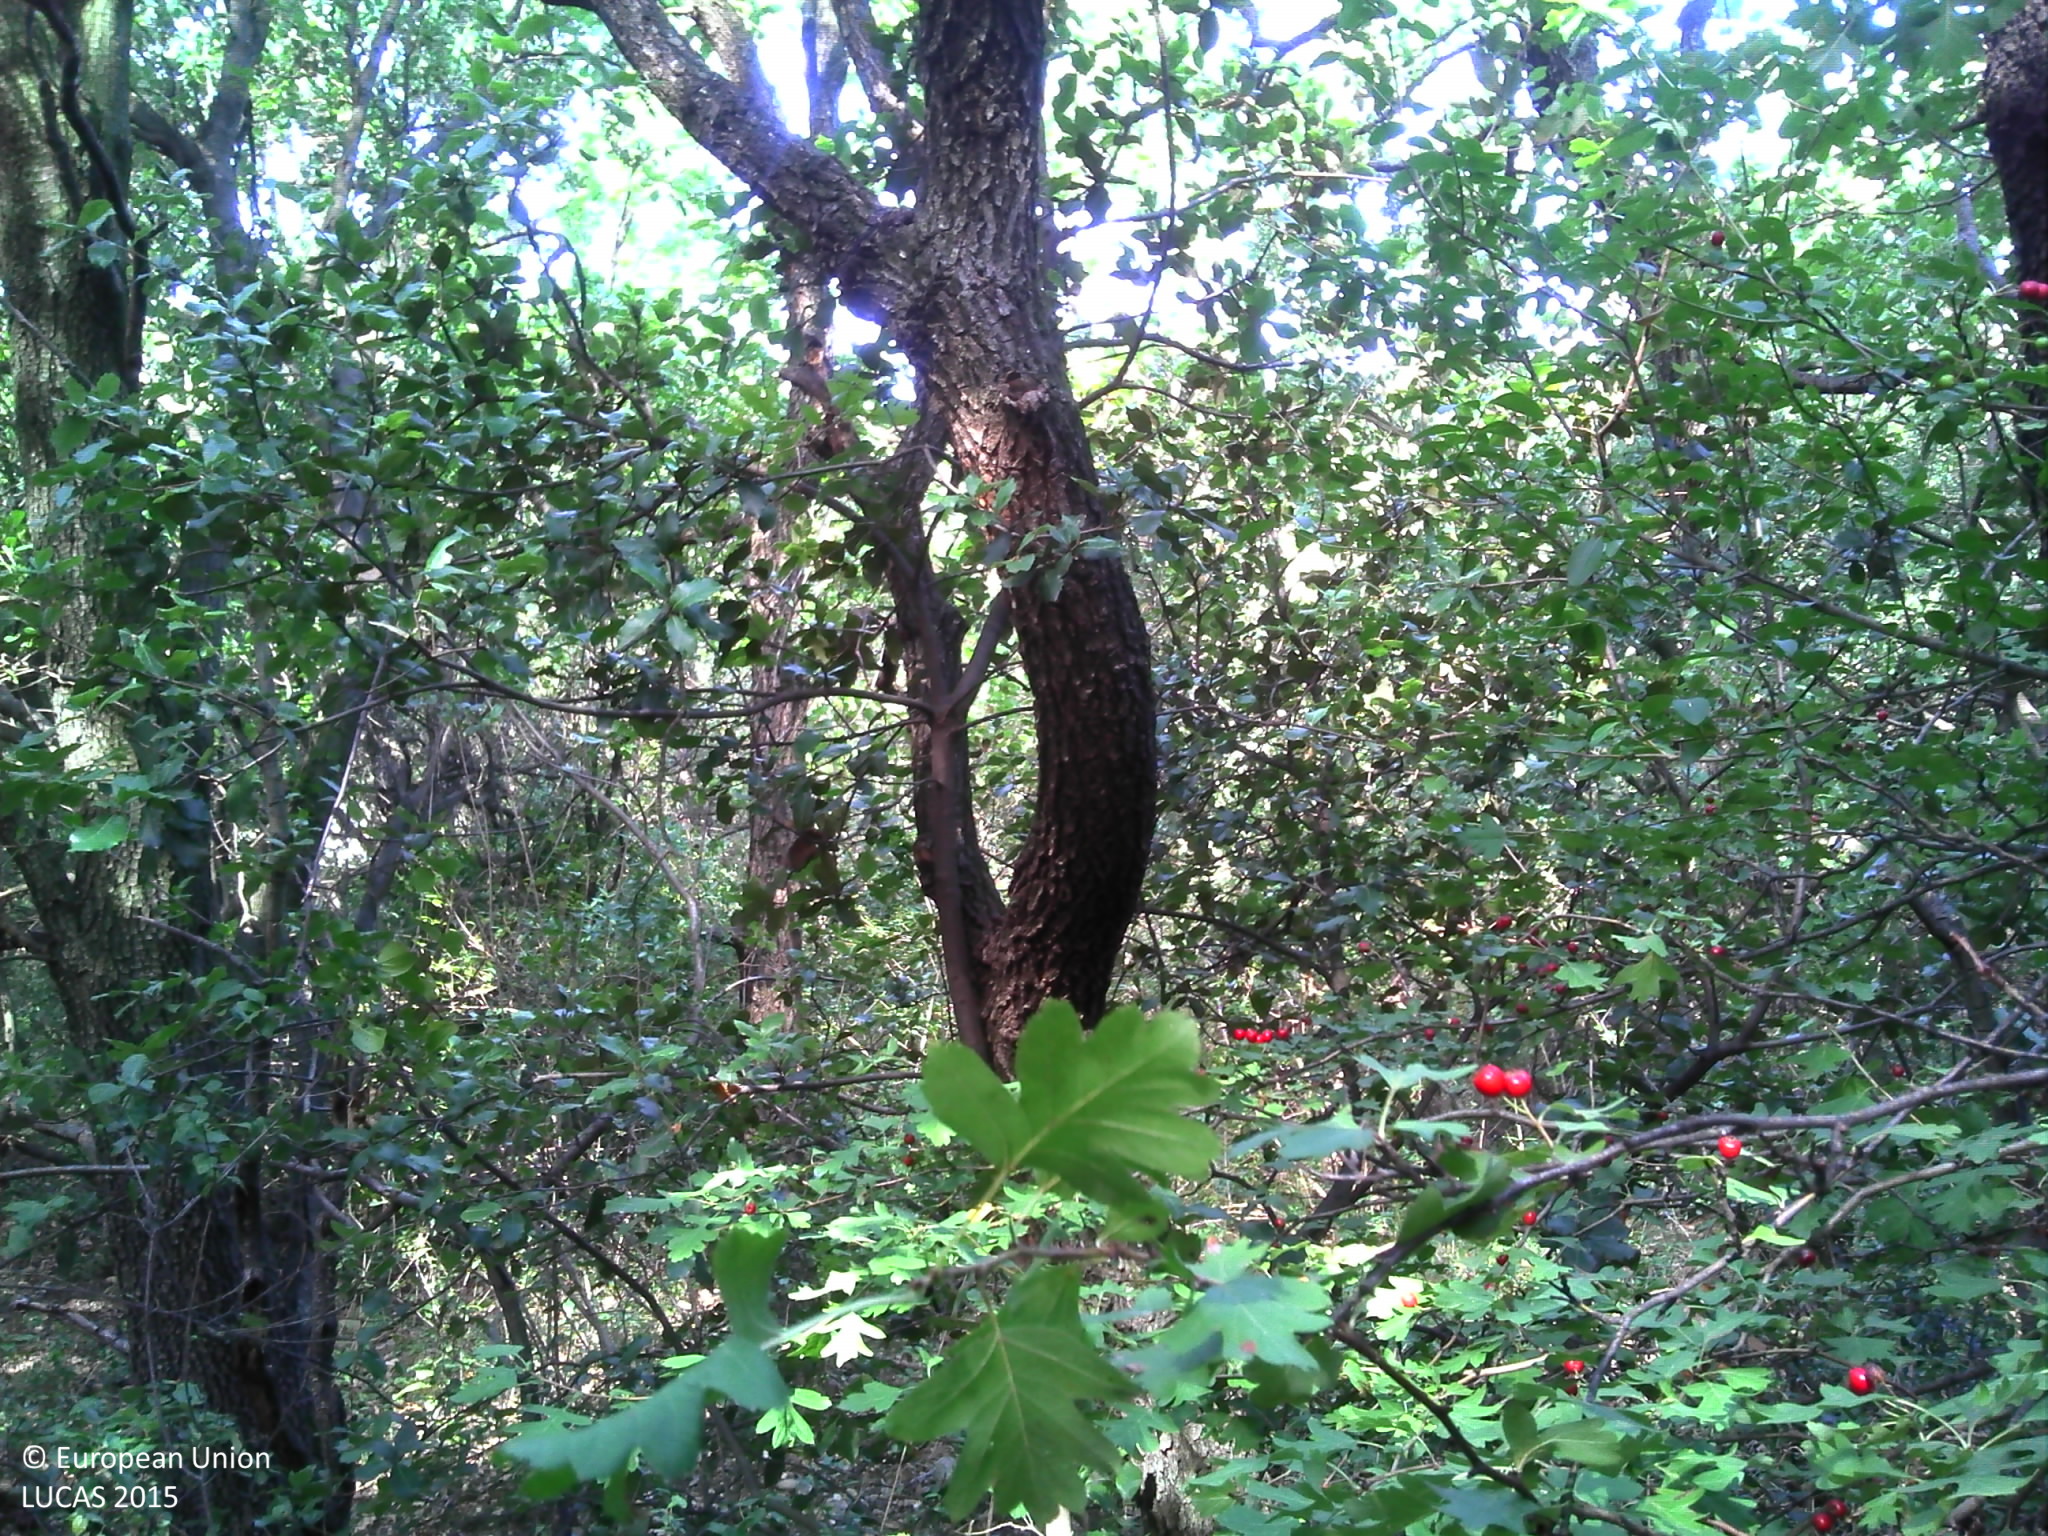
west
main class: Woodland
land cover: Broadleaved woodland
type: thermophilous deciduous forest
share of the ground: > 75 %
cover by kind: broadleaved forest trees 95 %, coniferous forest trees 5 %
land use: Semi-natural and natural areas not in use
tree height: > 5 m
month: September
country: FR
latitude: 44.4714
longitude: 4.7649
